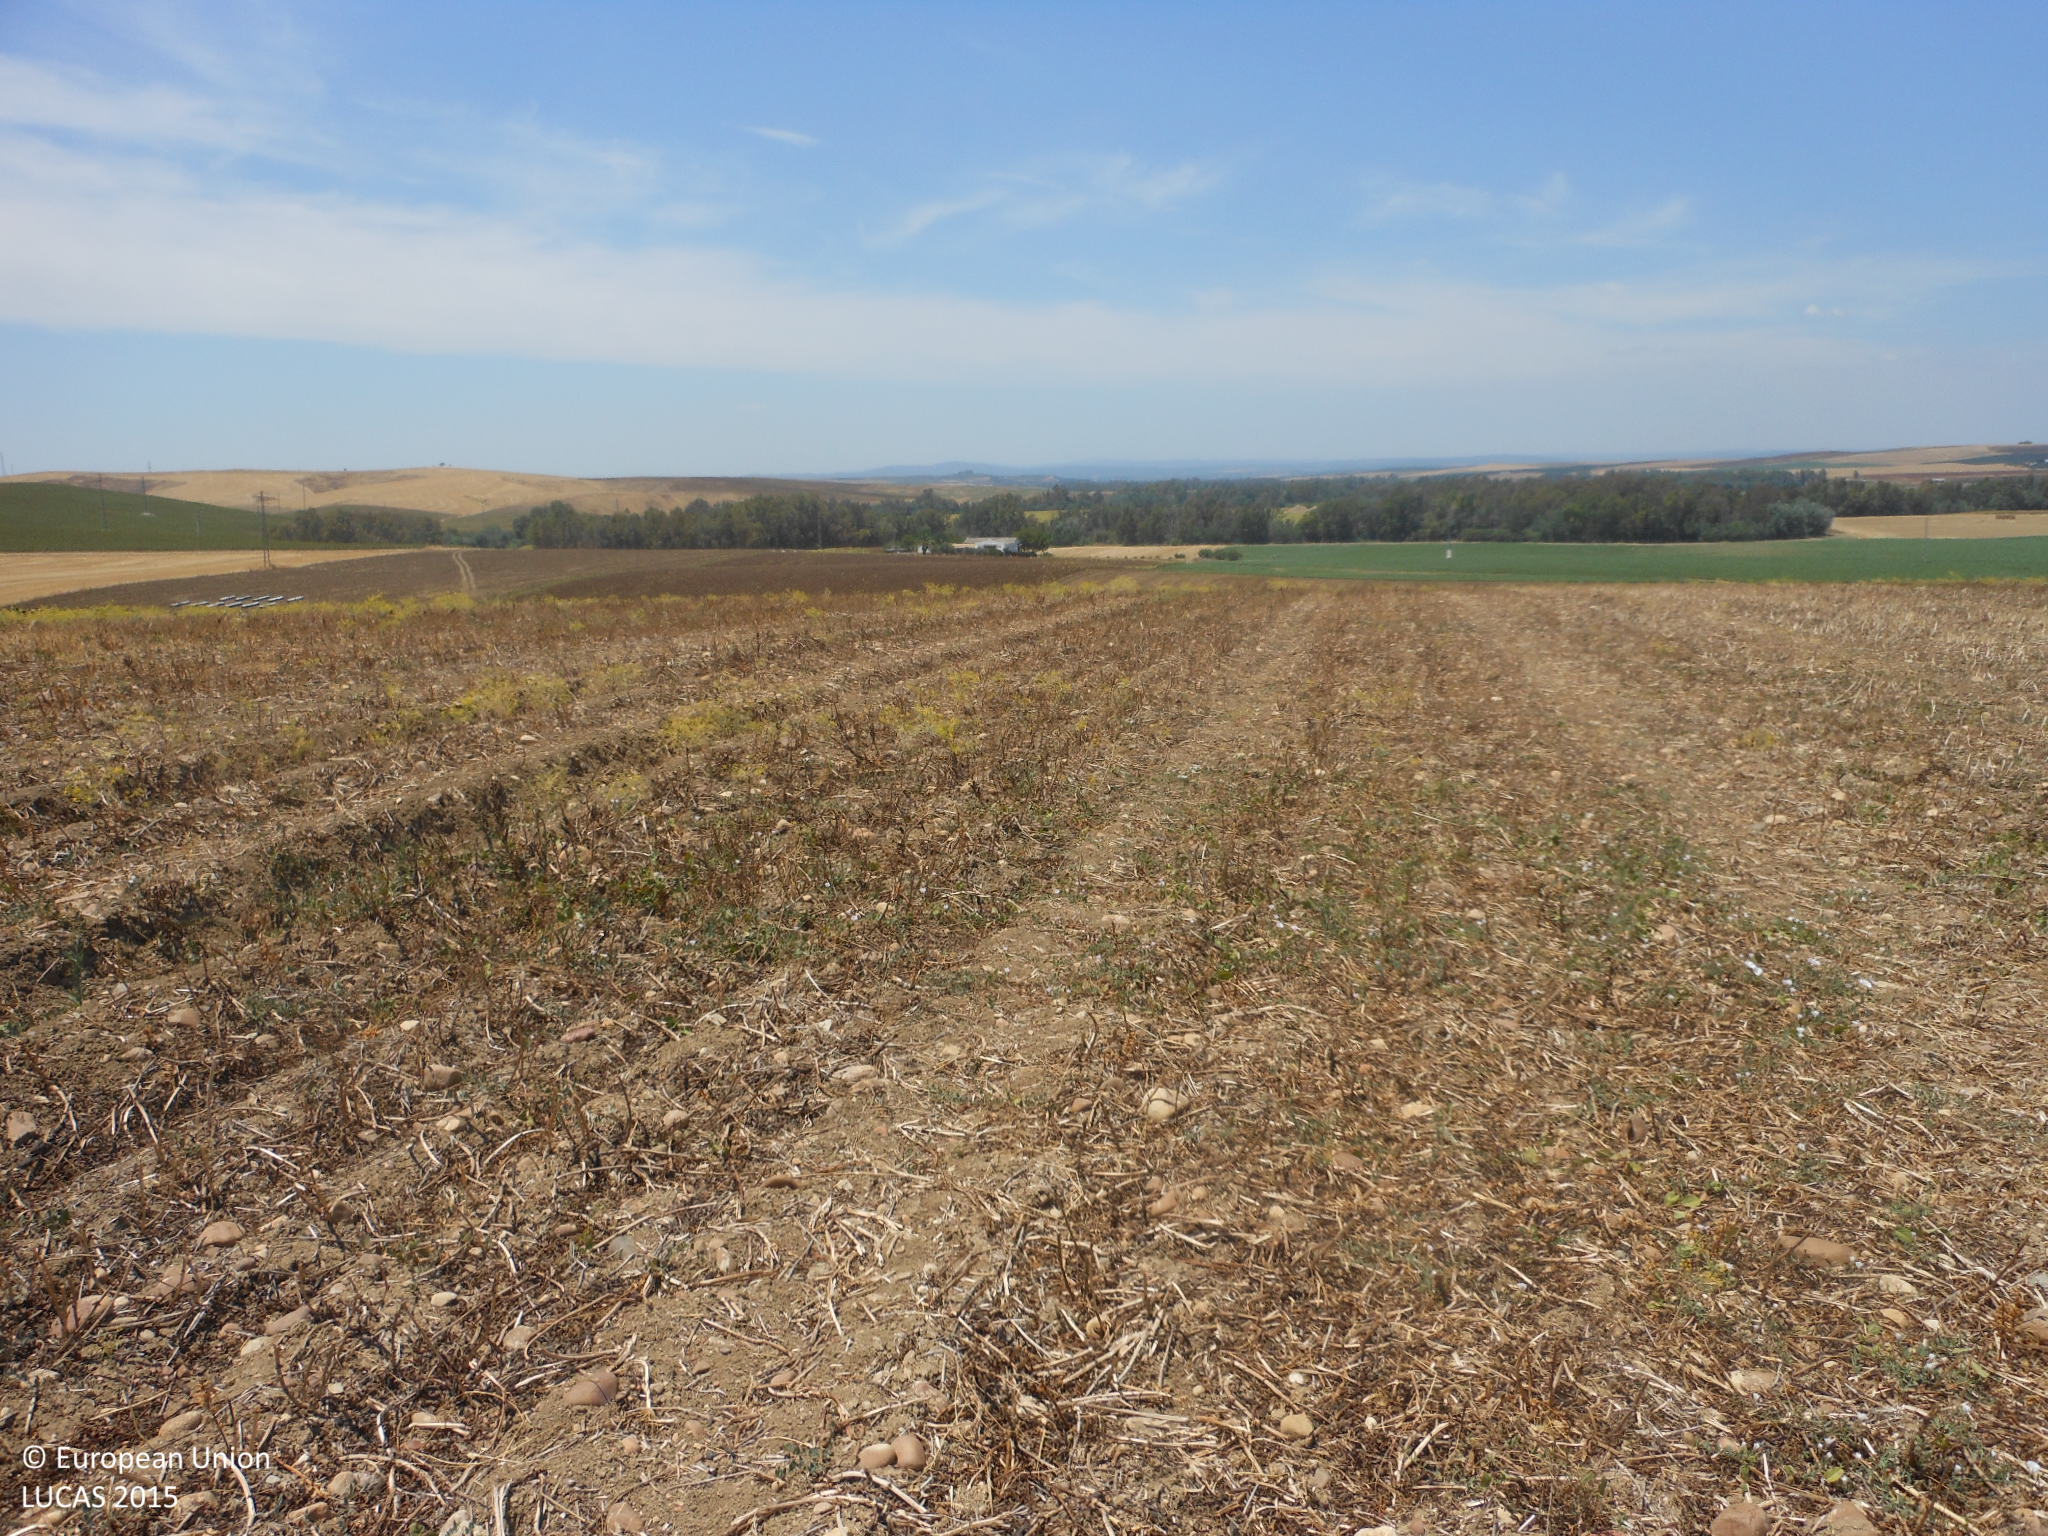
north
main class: Cropland
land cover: Dry pulses
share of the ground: < 10 %
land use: Agriculture (excluding fallow land and kitchen gardens)
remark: Harvested field
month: June
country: ES
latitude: 37.6140
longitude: -5.1386
